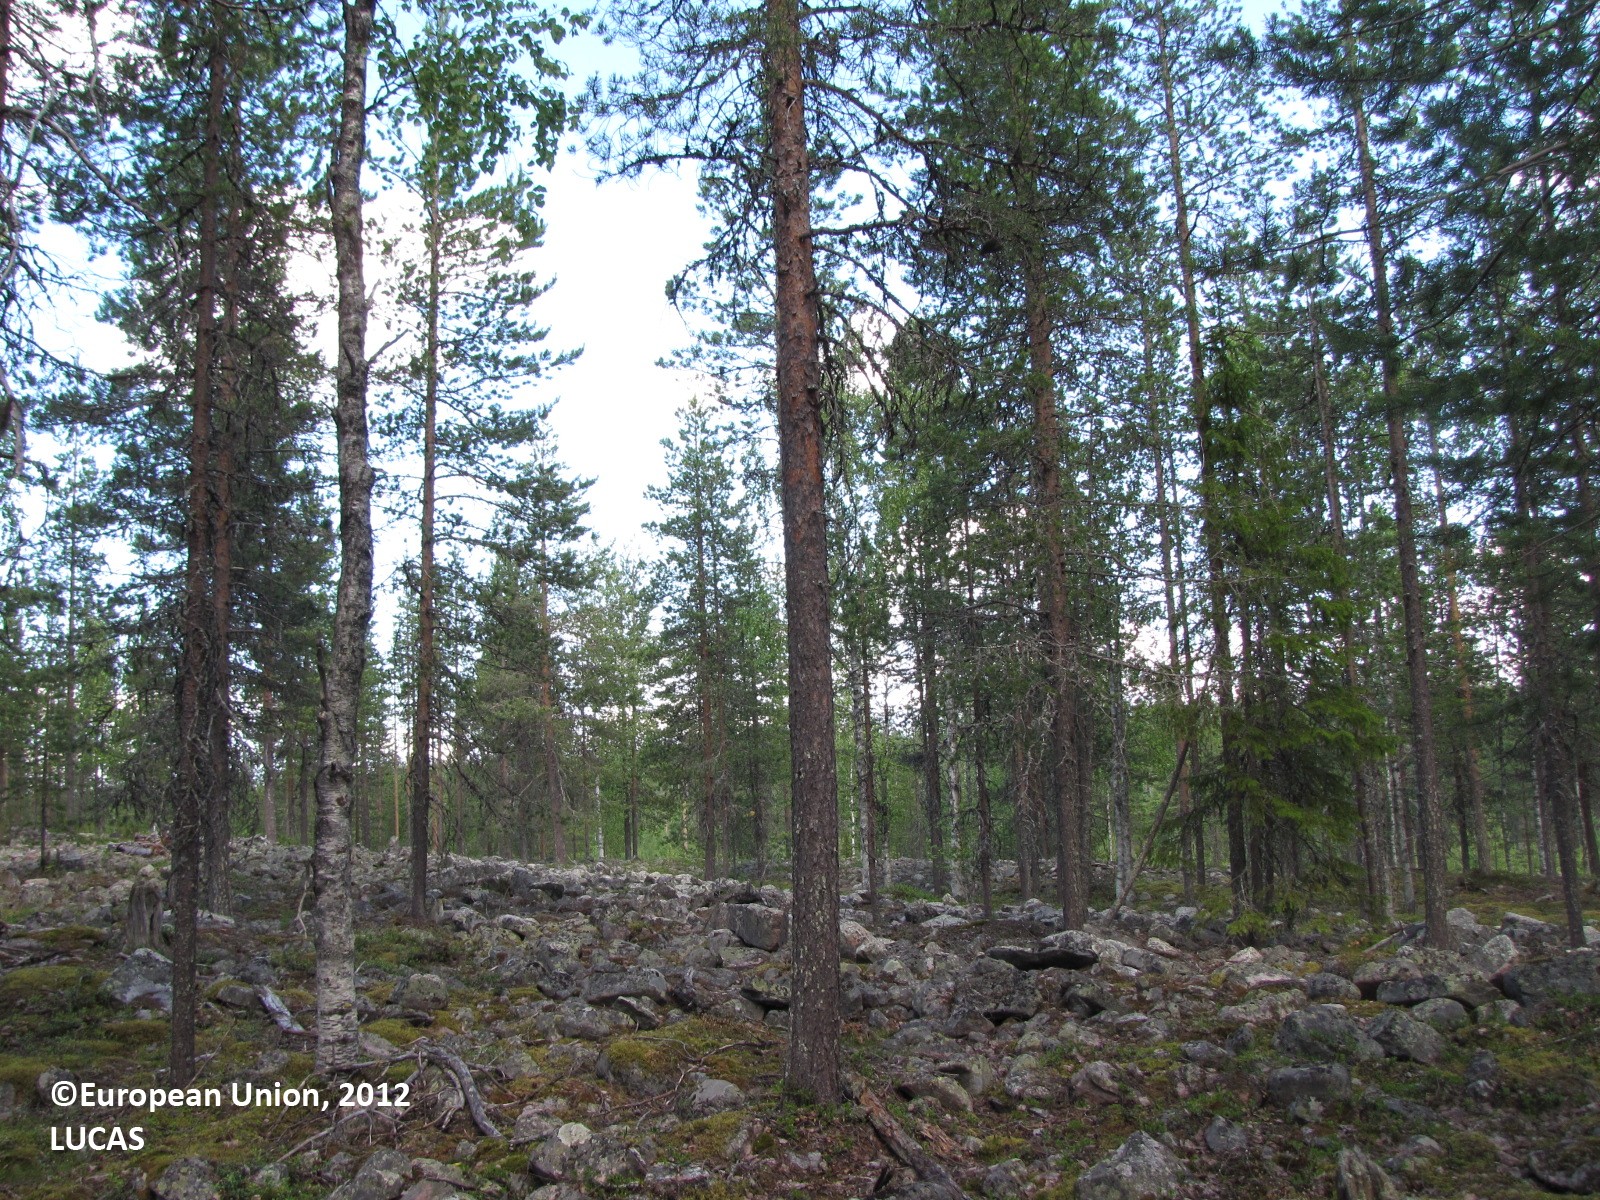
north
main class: Woodland
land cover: Pine dominated mixed woodland
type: boreal forest
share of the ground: 50 - 75 %
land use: Forestry
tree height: > 5 m
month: July
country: FI
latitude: 66.5139
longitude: 24.5033
